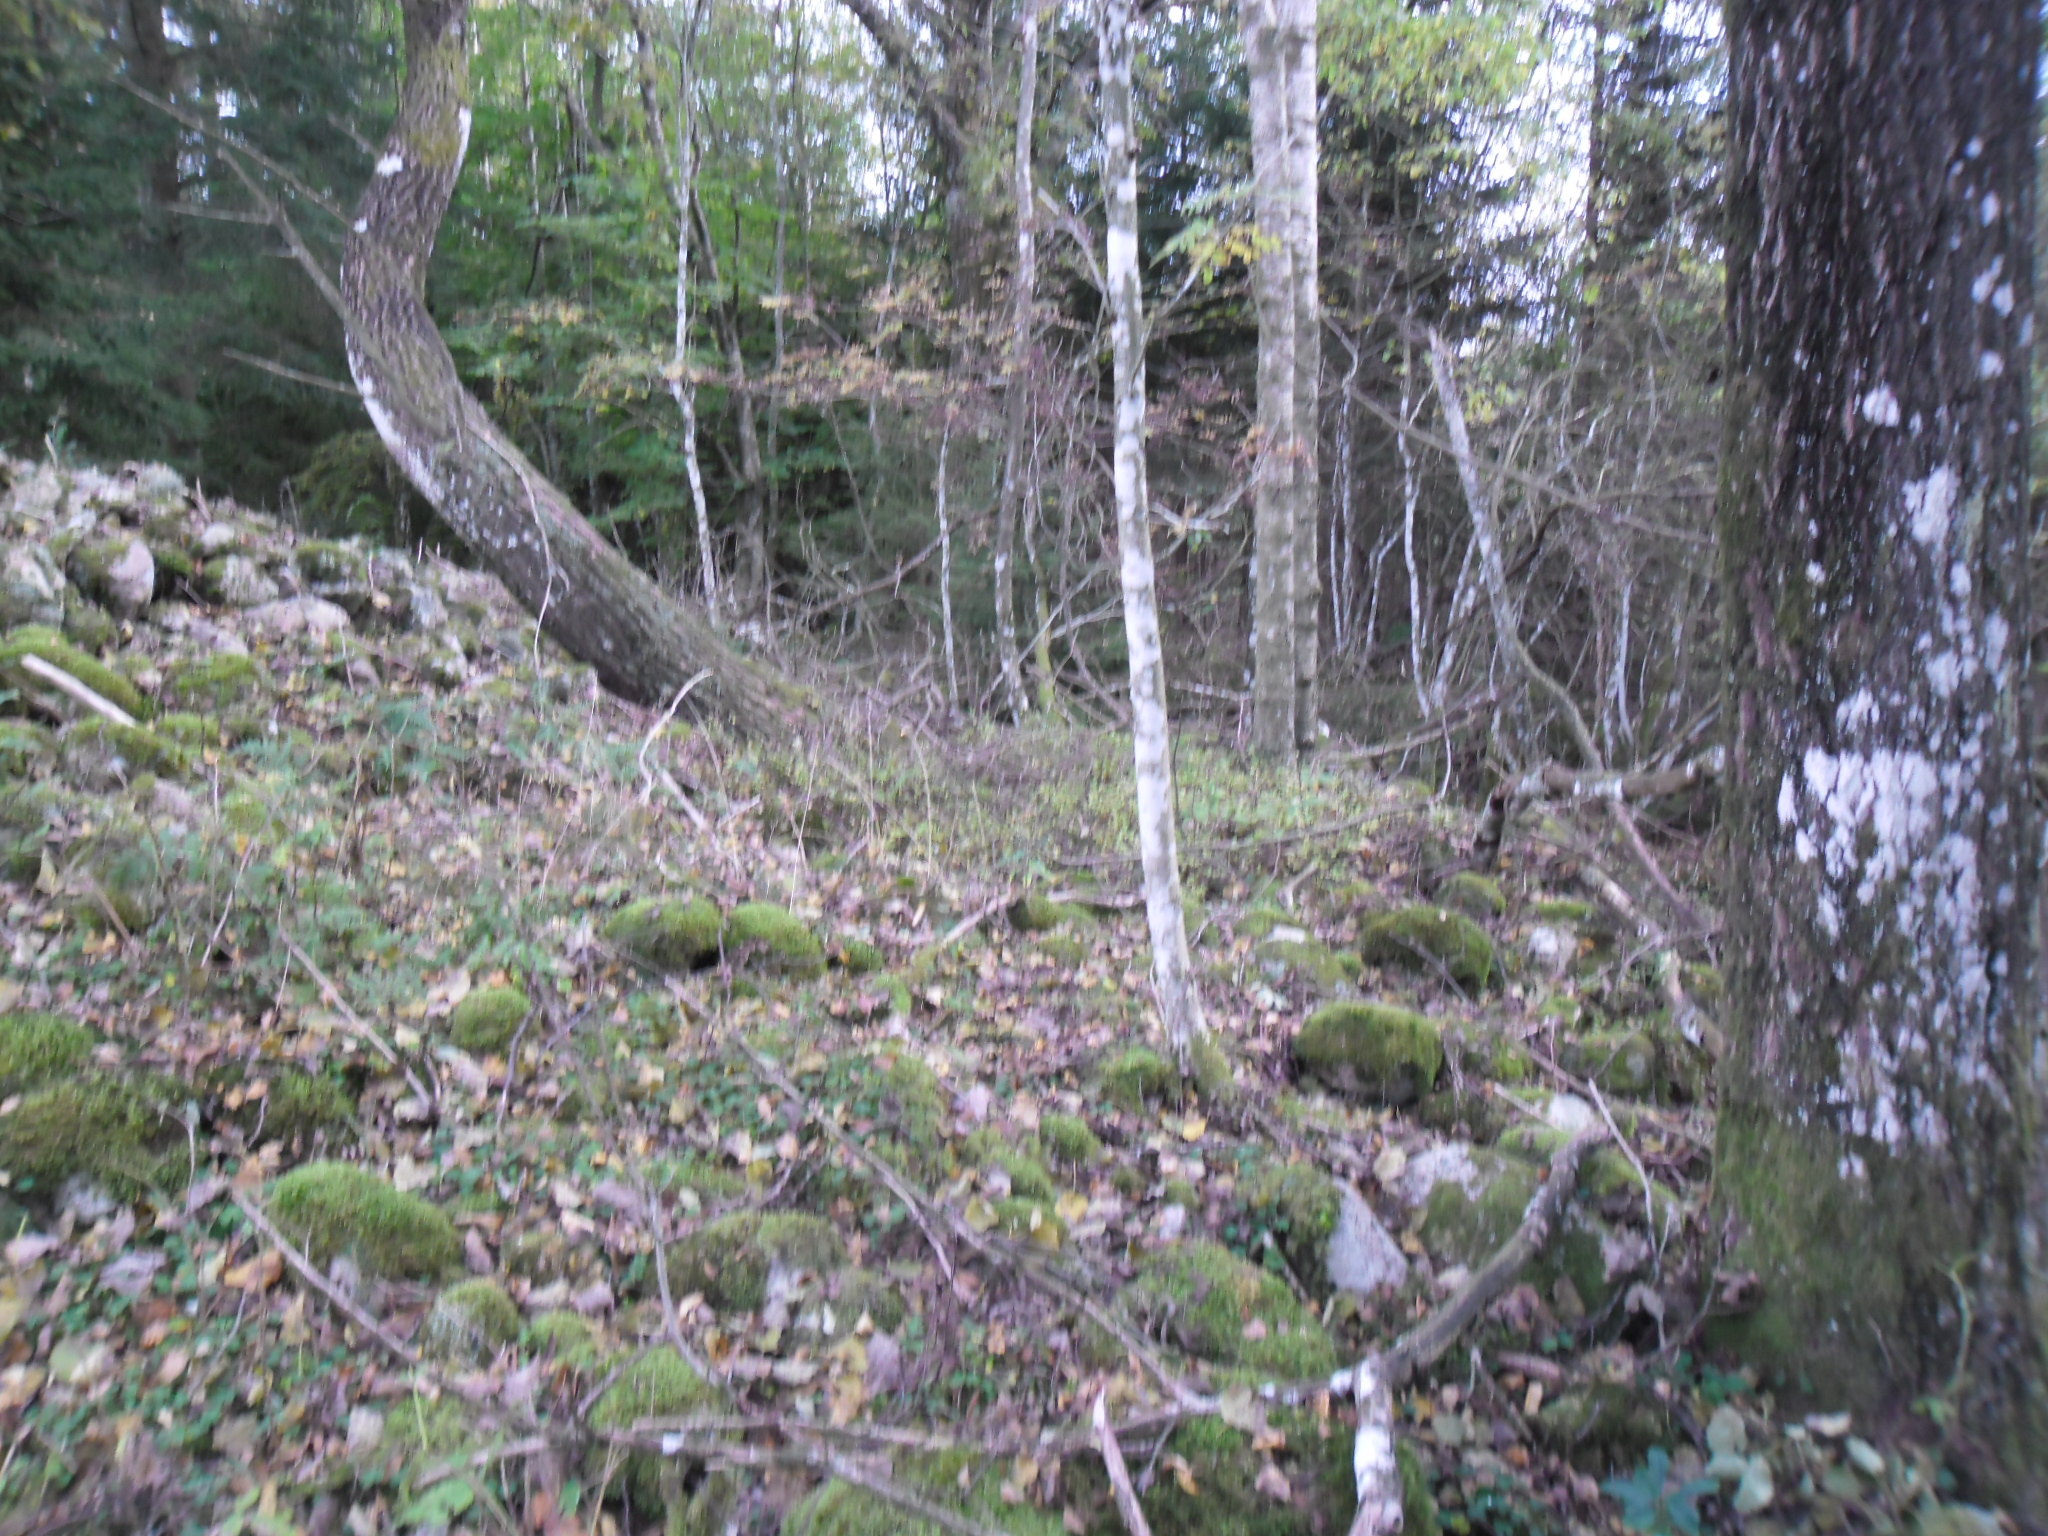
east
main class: Woodland
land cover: Broadleaved woodland
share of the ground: > 75 %
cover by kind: broadleaved forest trees 85 %, shrubs 15 %
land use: Forestry
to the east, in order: Broadleaved woodland; Spruce dominated coniferous woodland; Broadleaved woodland; Spruce dominated coniferous woodland
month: October
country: SE
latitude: 56.6335
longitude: 13.2085
